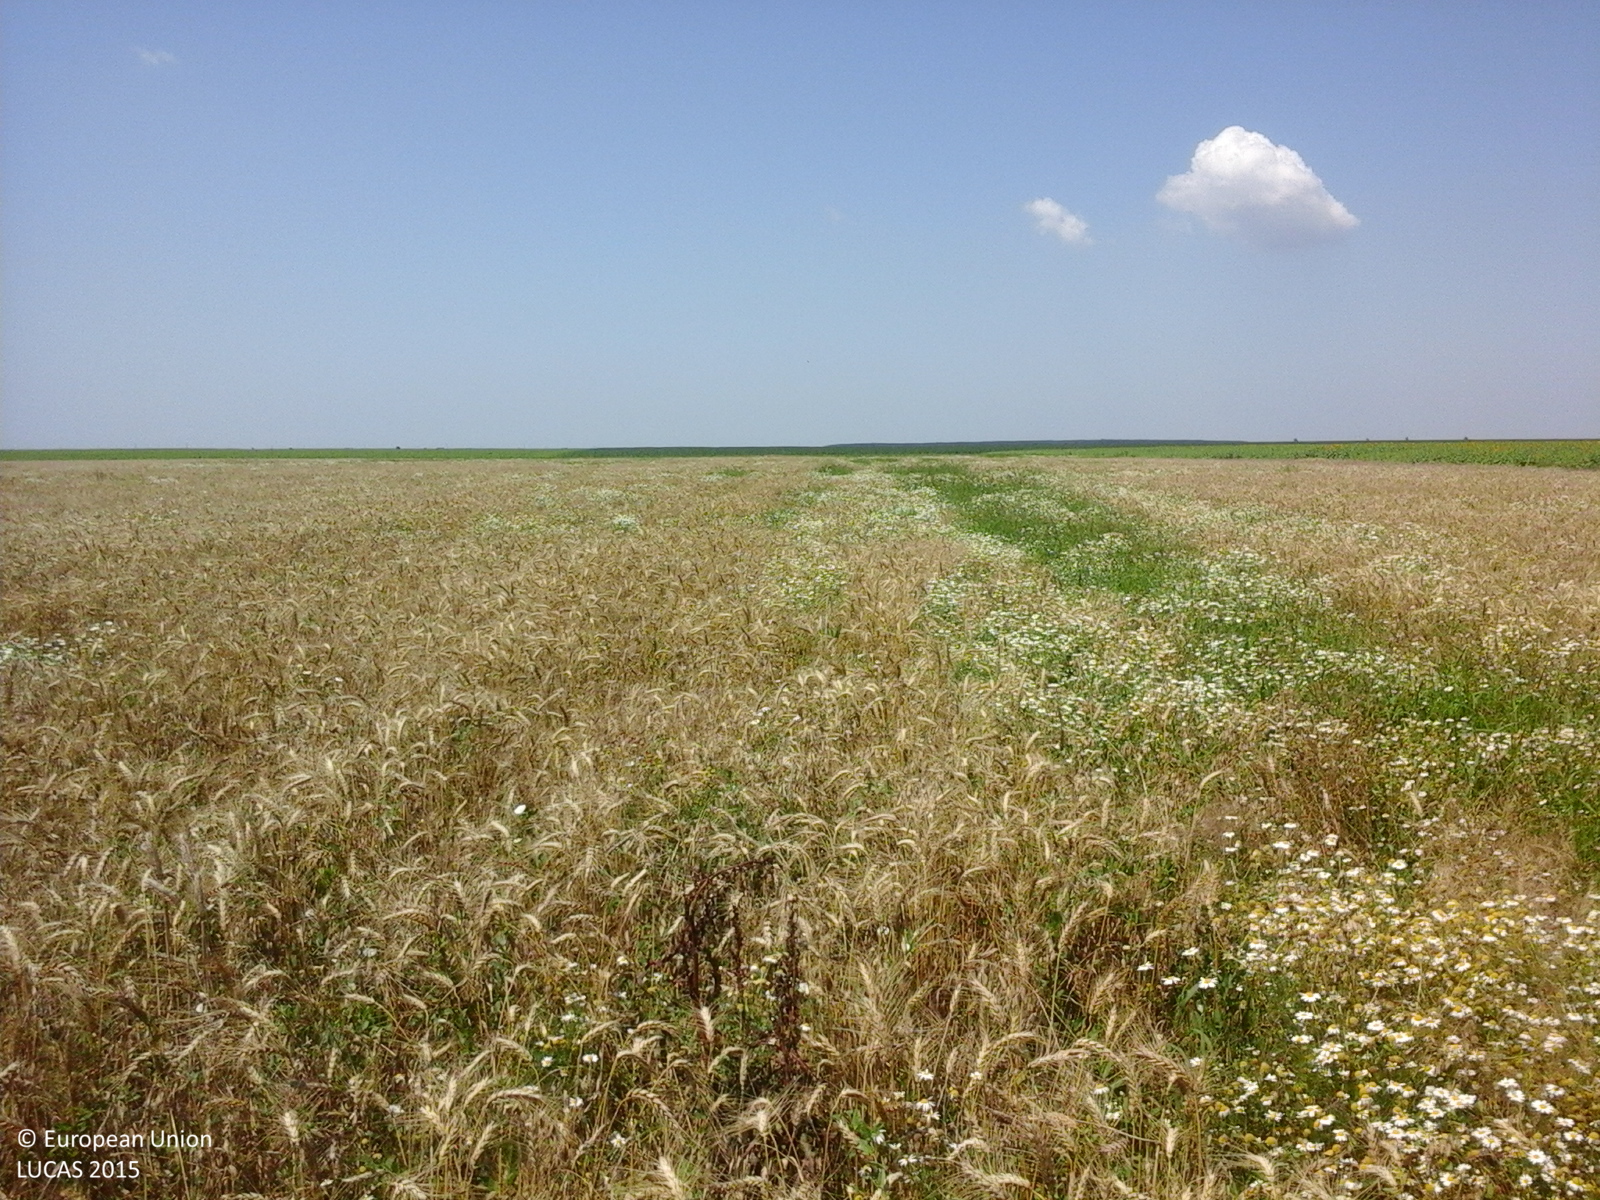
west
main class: Cropland
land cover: Common wheat
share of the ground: > 75 %
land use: Agriculture (excluding fallow land and kitchen gardens)
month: July
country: RO
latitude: 44.4199
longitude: 24.5272
